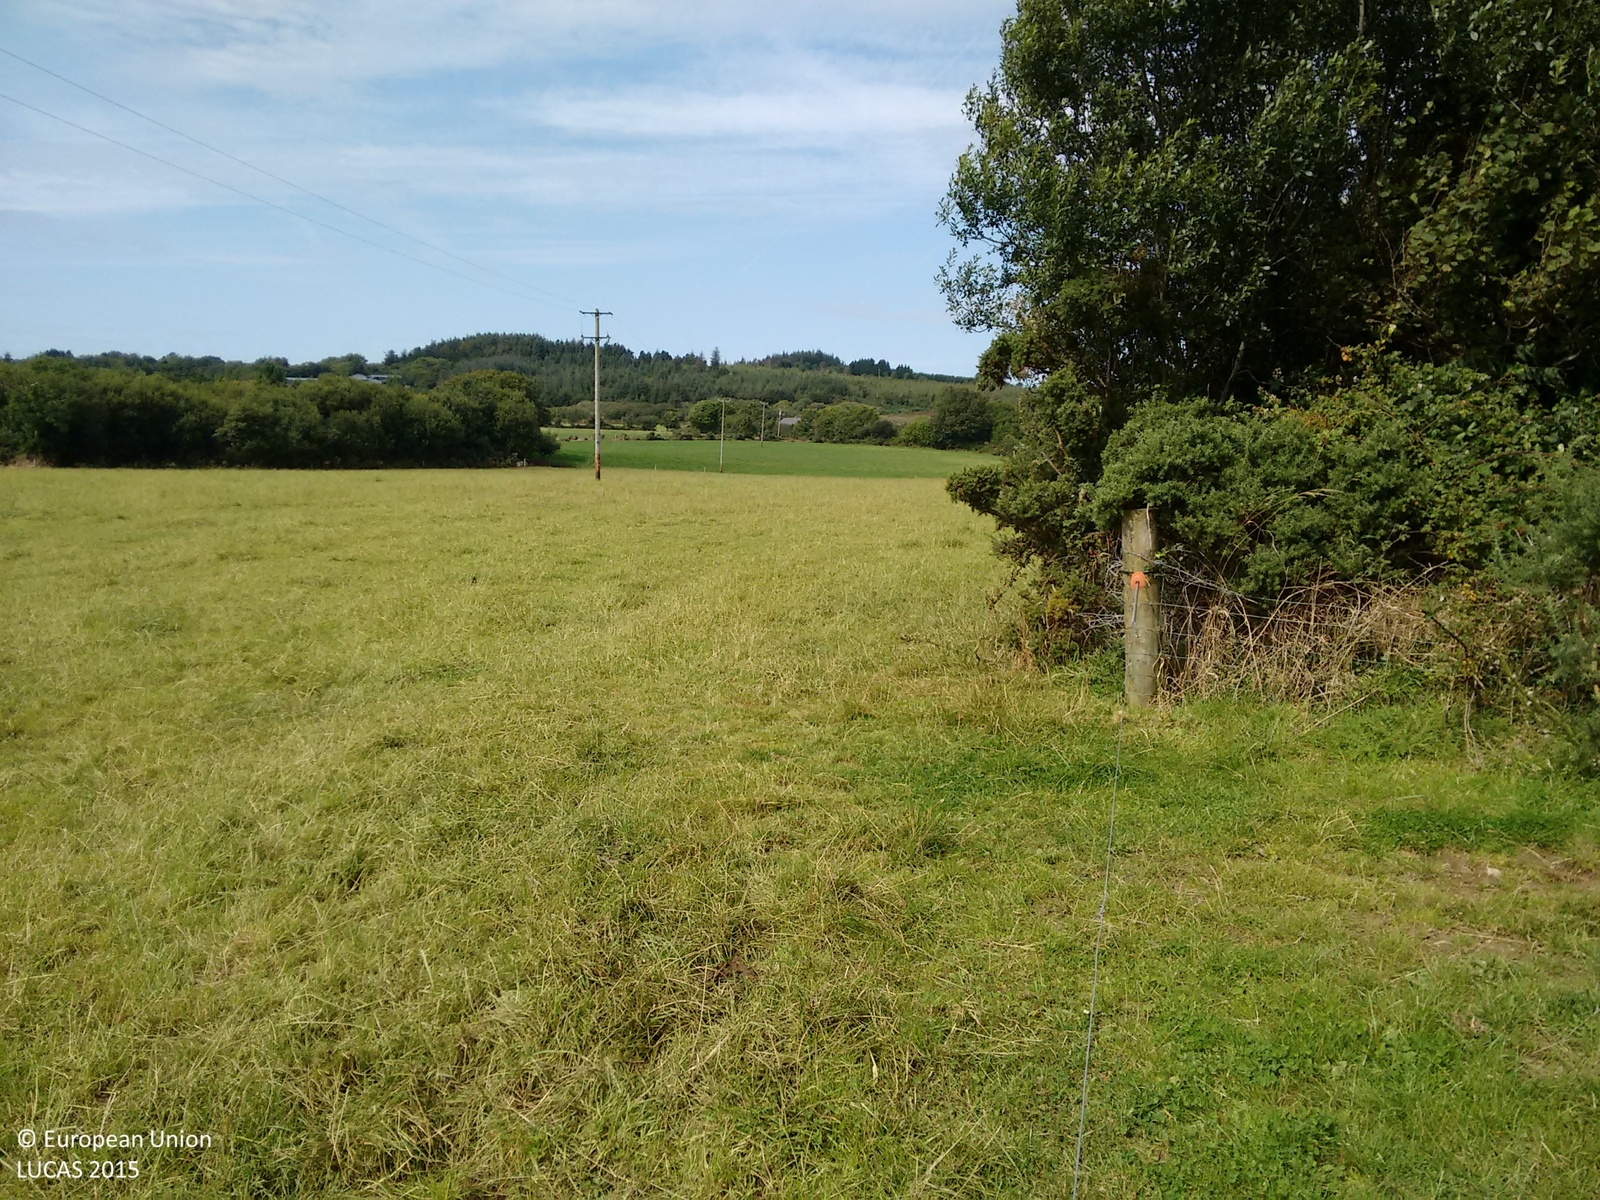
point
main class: Grassland
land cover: Grassland without tree/shrub cover
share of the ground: > 75 %
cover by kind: herbaceous plants 100 %
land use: Agriculture (excluding fallow land and kitchen gardens)
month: August
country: IE
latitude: 52.3293
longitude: -6.5192
